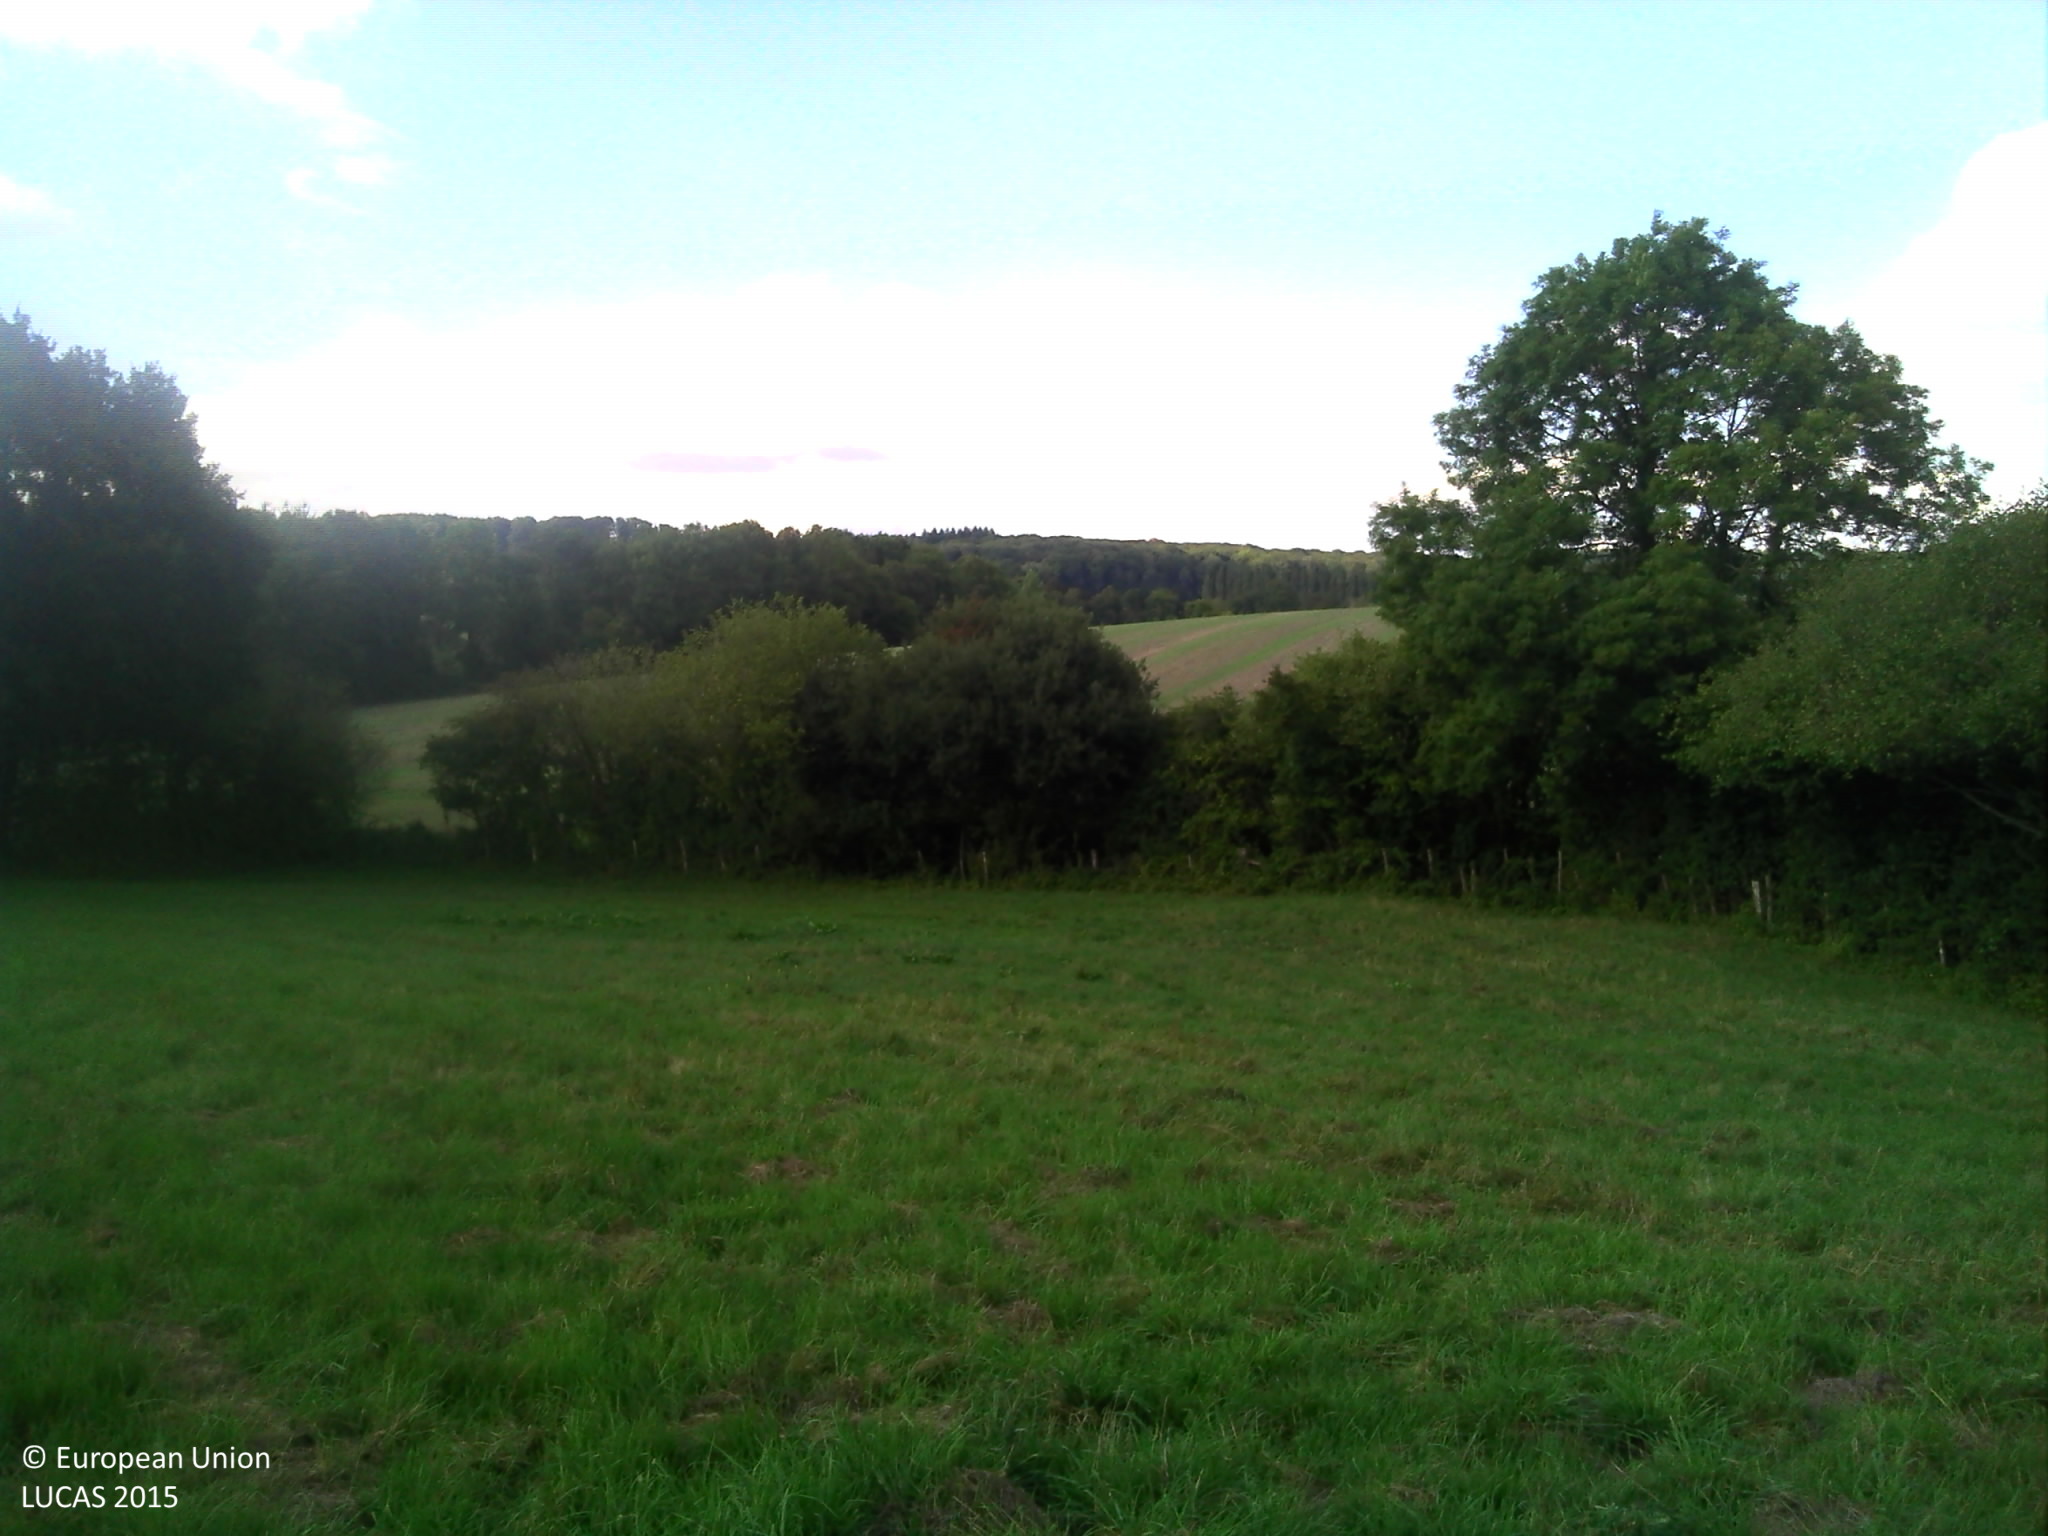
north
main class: Grassland
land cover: Grassland without tree/shrub cover
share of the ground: > 75 %
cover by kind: herbaceous plants 100 %
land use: Agriculture (excluding fallow land and kitchen gardens)
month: September
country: FR
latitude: 48.3797
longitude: 0.5653
